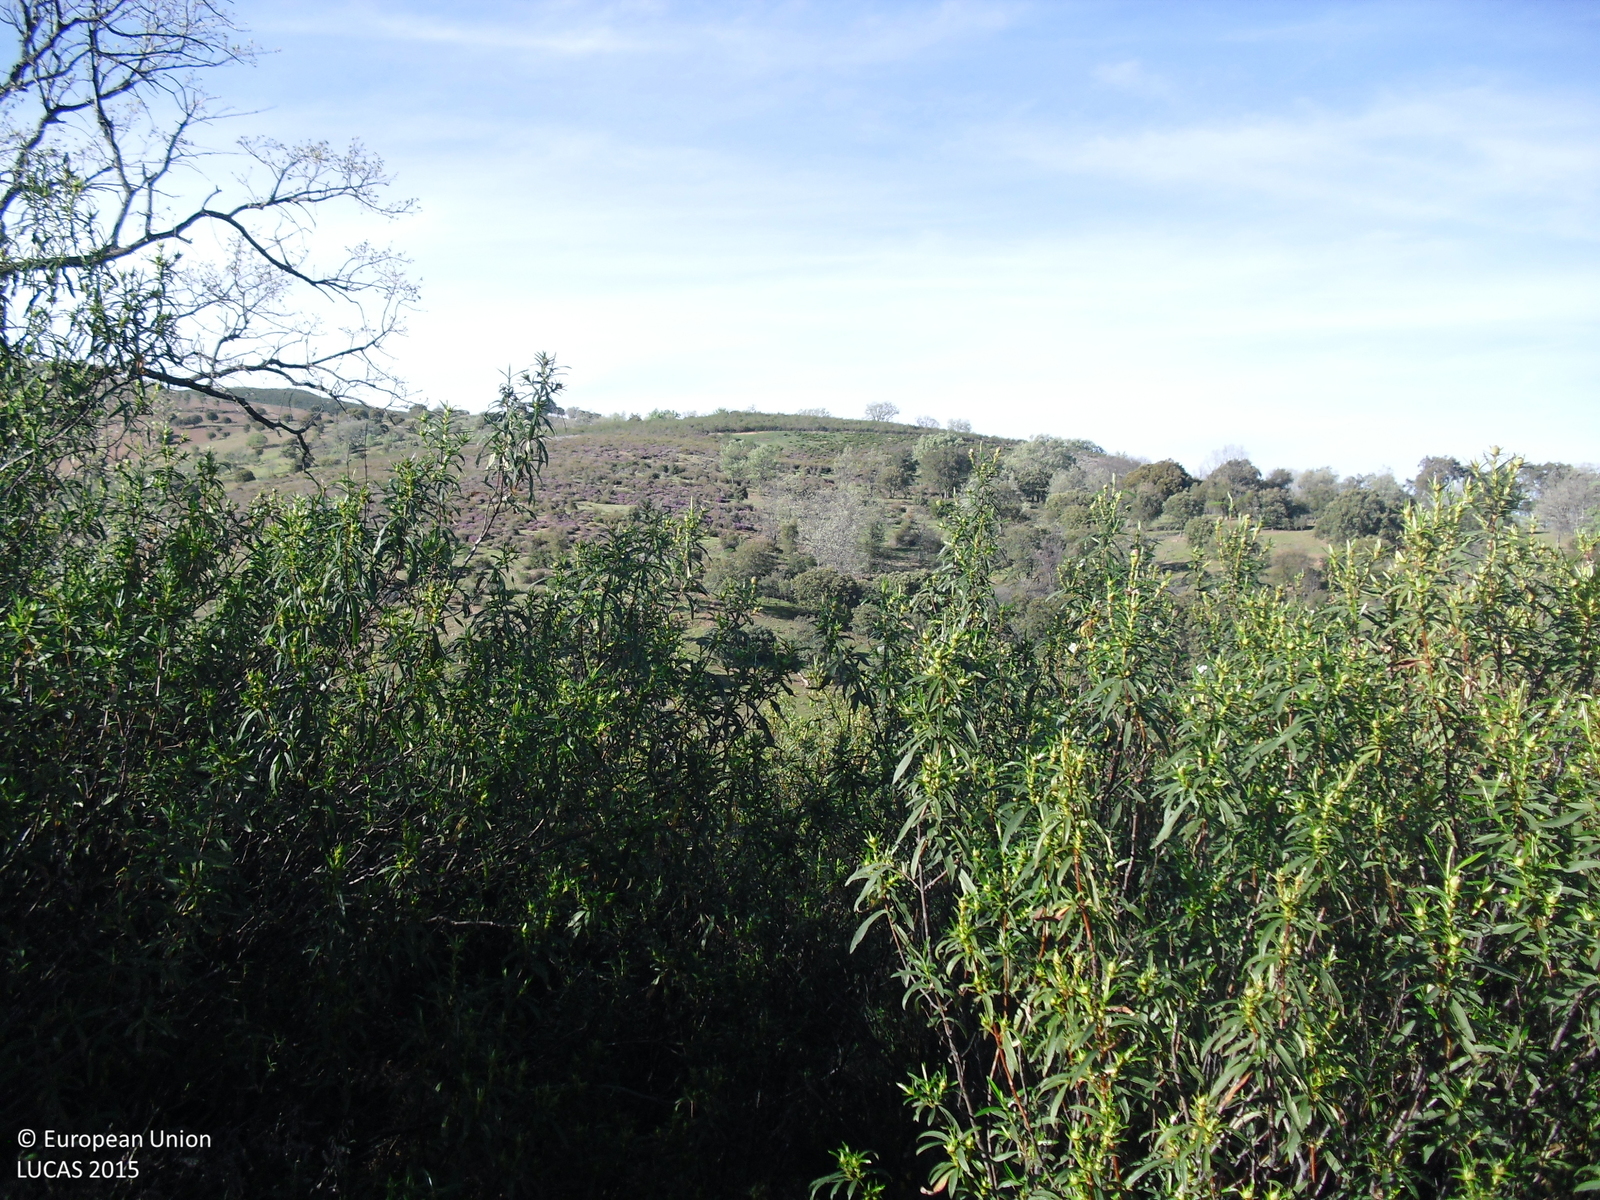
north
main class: Shrubland
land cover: Shrubland with sparse tree cover
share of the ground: 10 - 25 %
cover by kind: shrubs 85 %, herbaceous plants 10 %, broadleaved forest trees 5 %
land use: Semi-natural and natural areas not in use
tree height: > 5 m
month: April
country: ES
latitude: 39.4019
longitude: -5.3415
